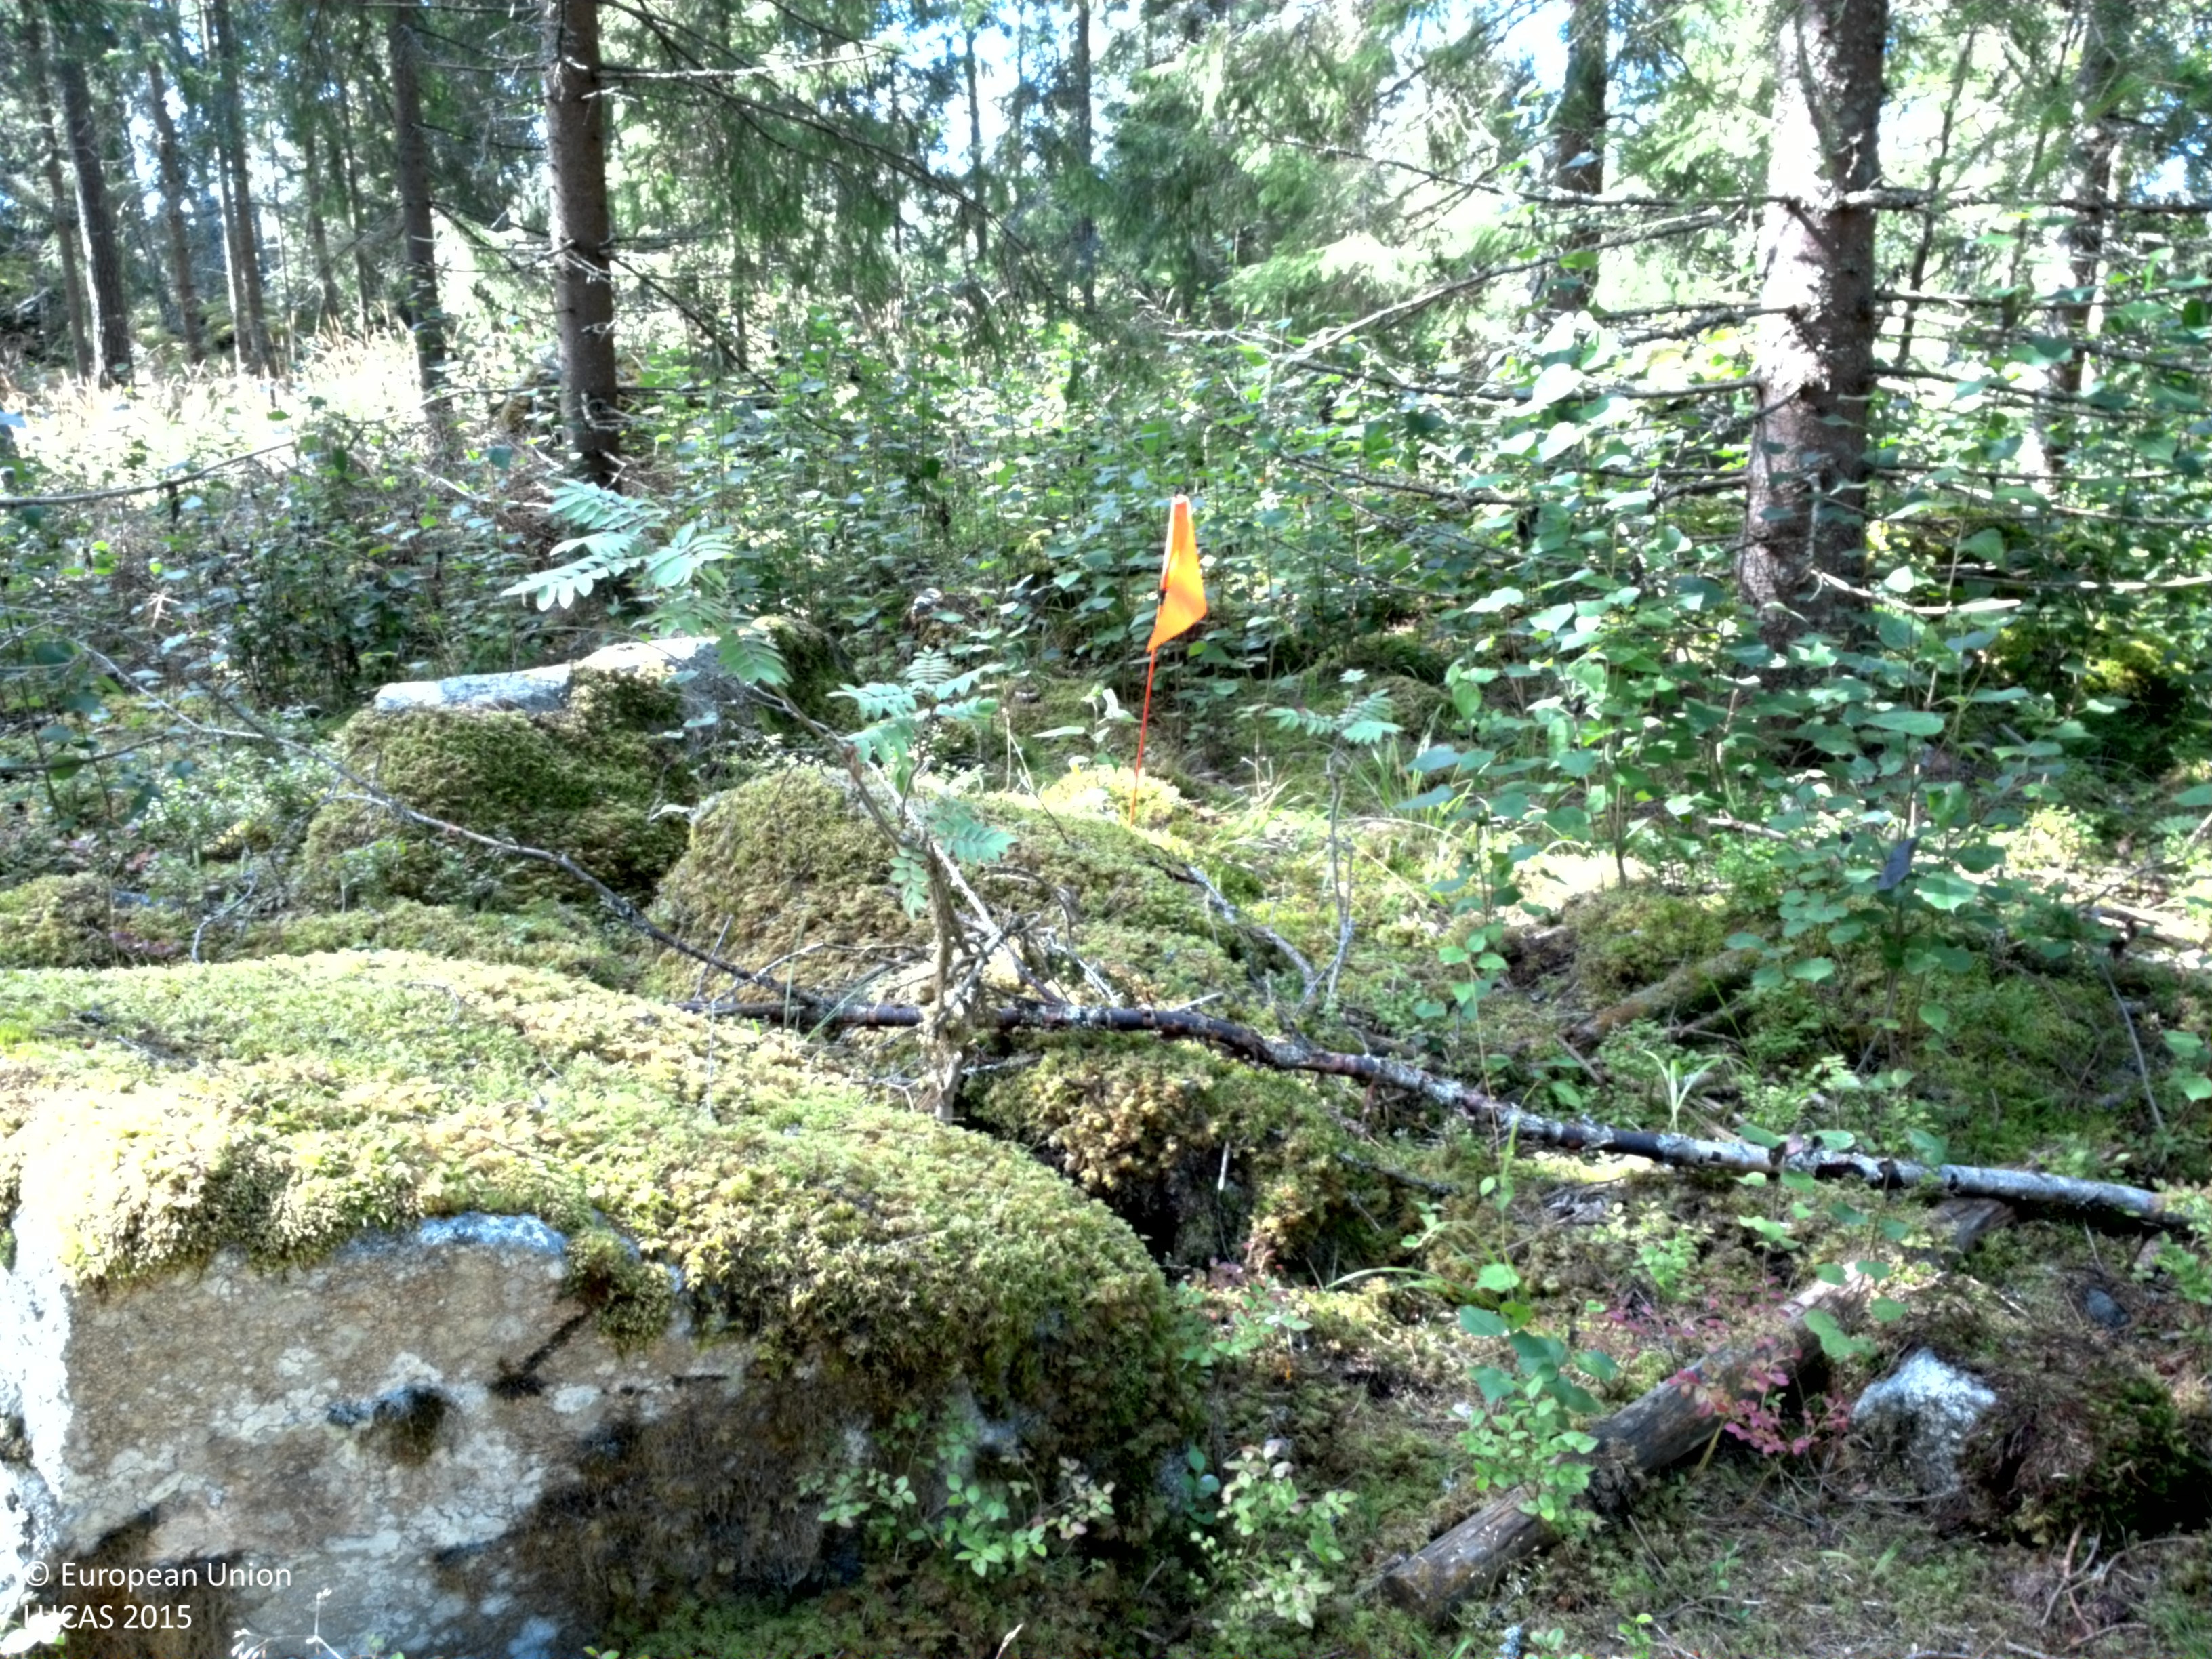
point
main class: Woodland
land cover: Spruce dominated coniferous woodland
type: boreal forest
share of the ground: > 75 %
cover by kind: coniferous forest trees 75 %, lichens and mosses 15 %, broadleaved forest trees 5 %, shrubs 5 %
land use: Forestry
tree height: > 5 m
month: August
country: SE
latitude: 59.8954
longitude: 16.3001
